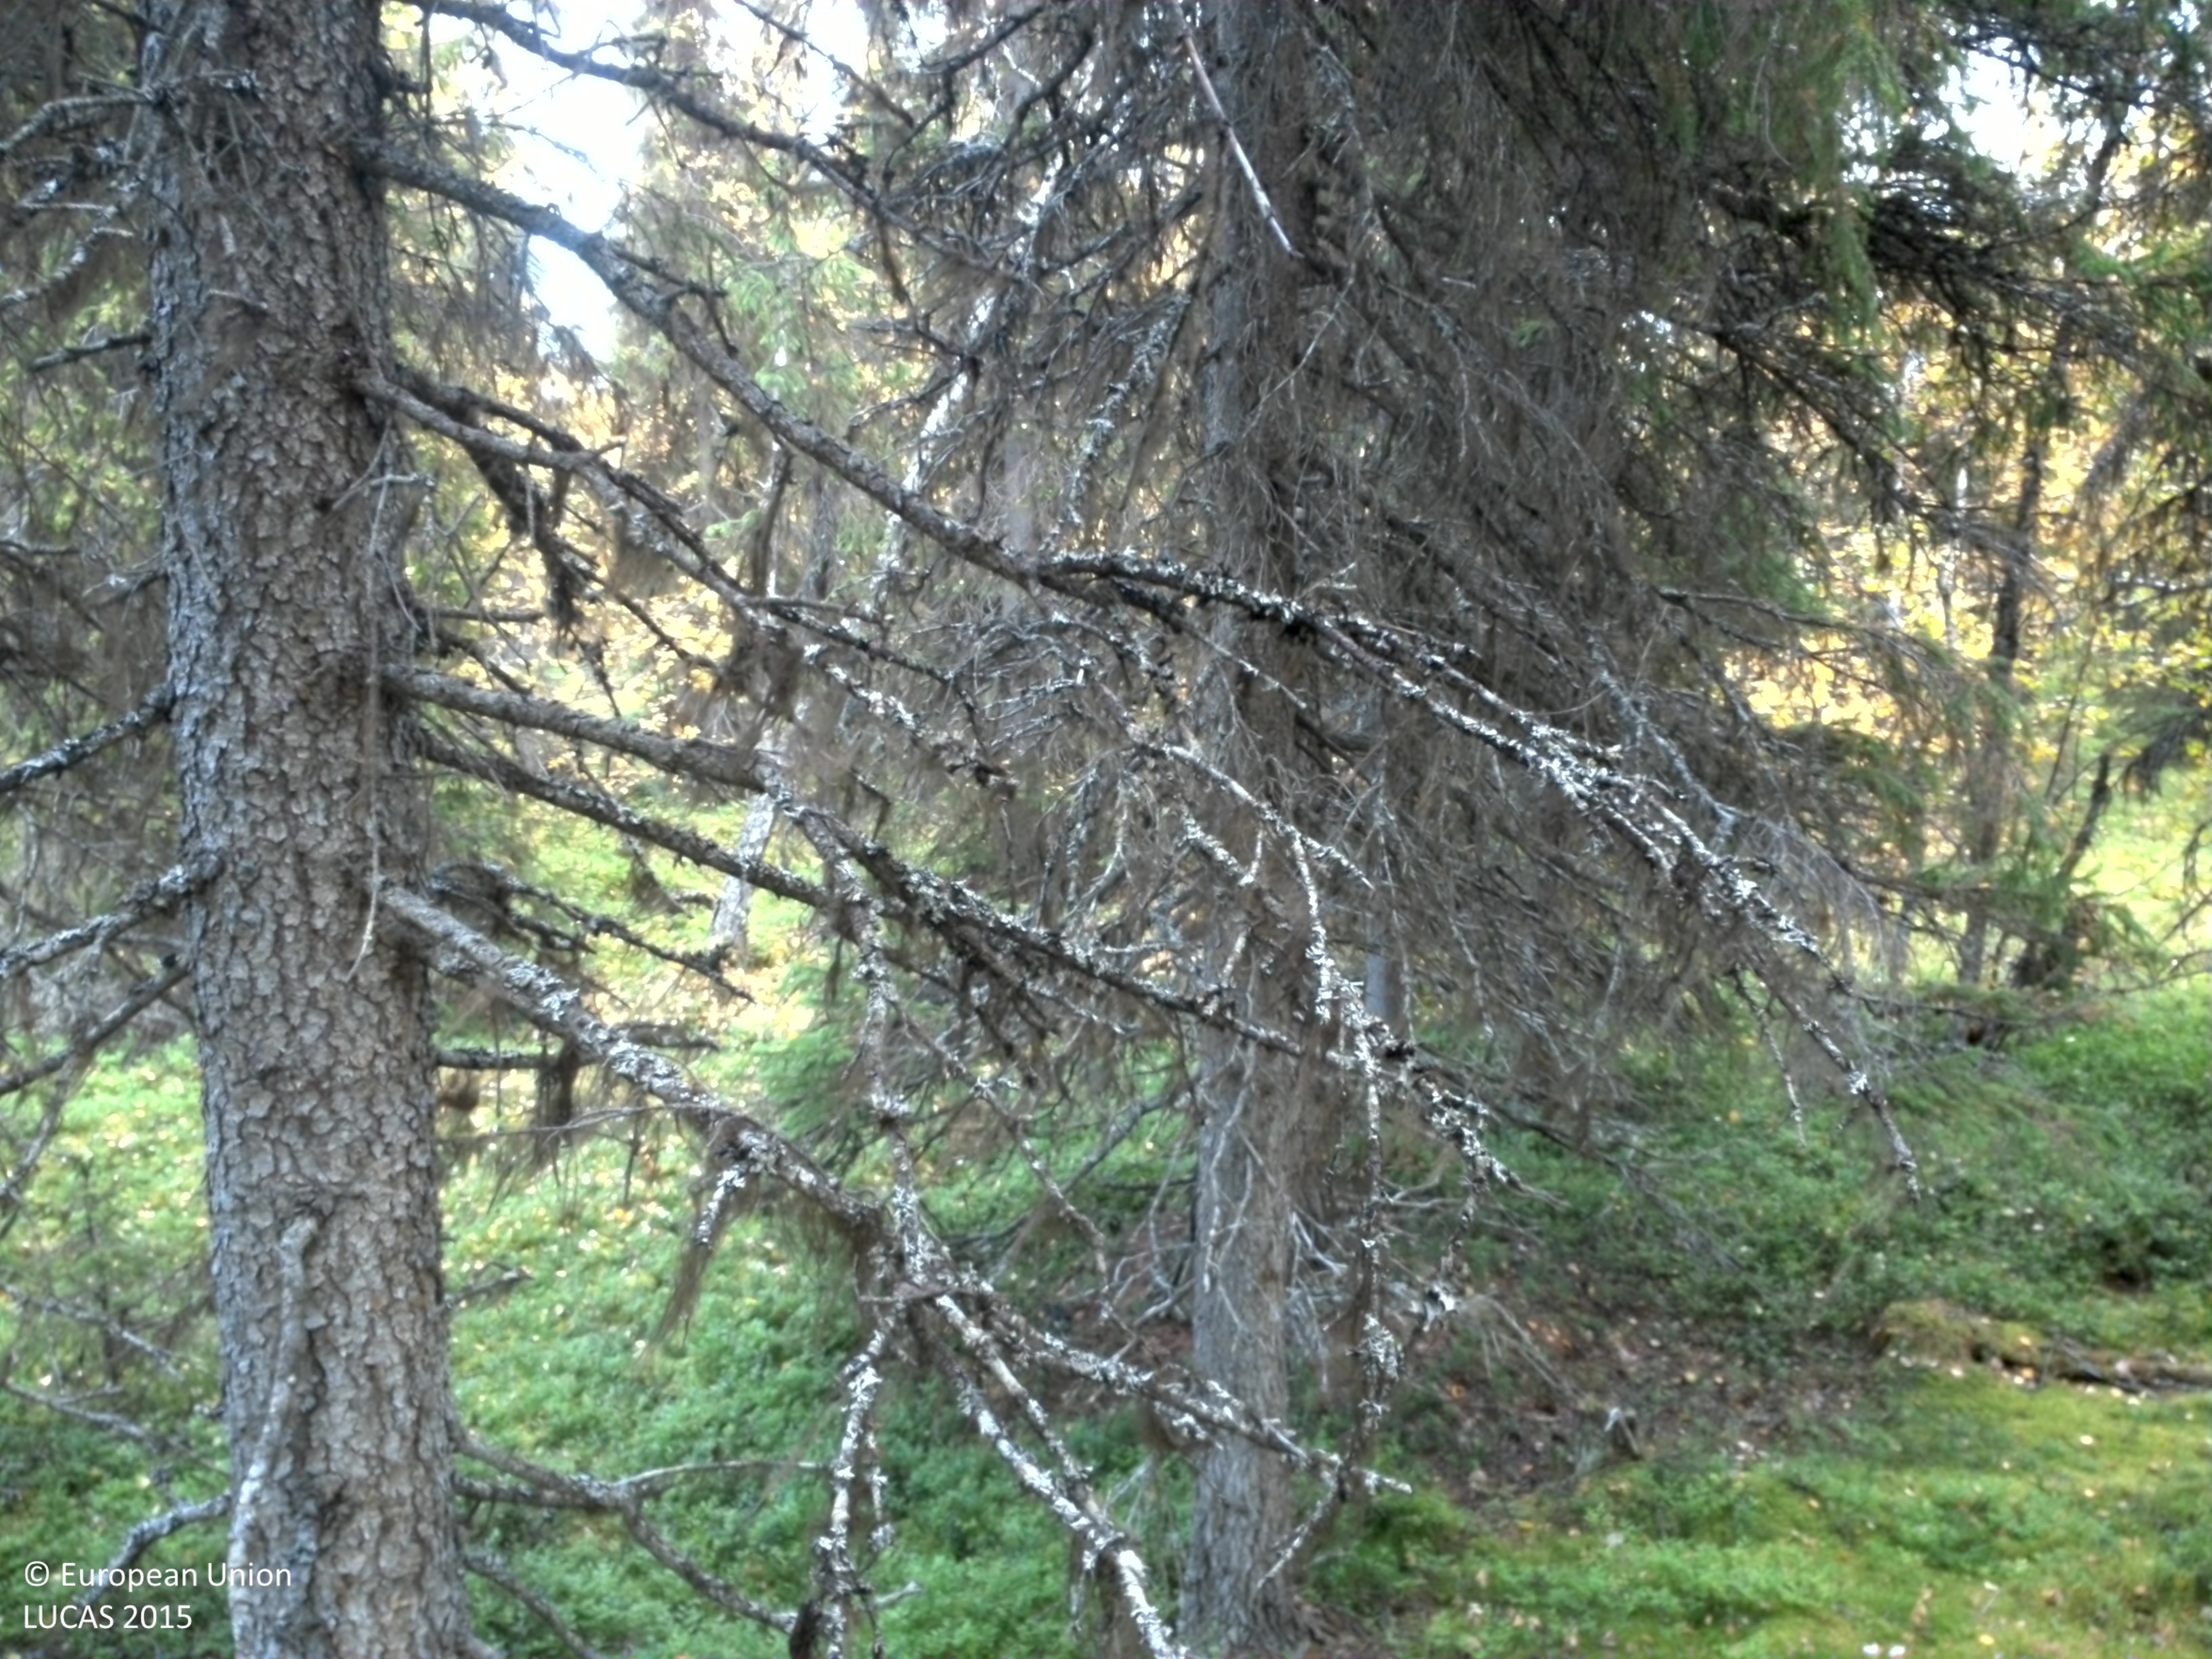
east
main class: Woodland
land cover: Spruce dominated mixed woodland
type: boreal forest
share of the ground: 25 - 50 %
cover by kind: shrubs 35 %, lichens and mosses 30 %, coniferous forest trees 20 %, broadleaved forest trees 10 %, herbaceous plants 5 %
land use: Forestry
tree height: > 5 m
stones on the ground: 10 - 25 %
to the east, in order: Spruce dominated mixed woodland; Shrubland without tree cover; Spruce dominated mixed woodland; Rivers and streams; Spruce dominated mixed woodland; Shrubland with sparse tree cover; Spruce dominated mixed woodland; Shrubland with sparse tree cover
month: September
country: SE
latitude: 65.1462
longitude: 16.6802
